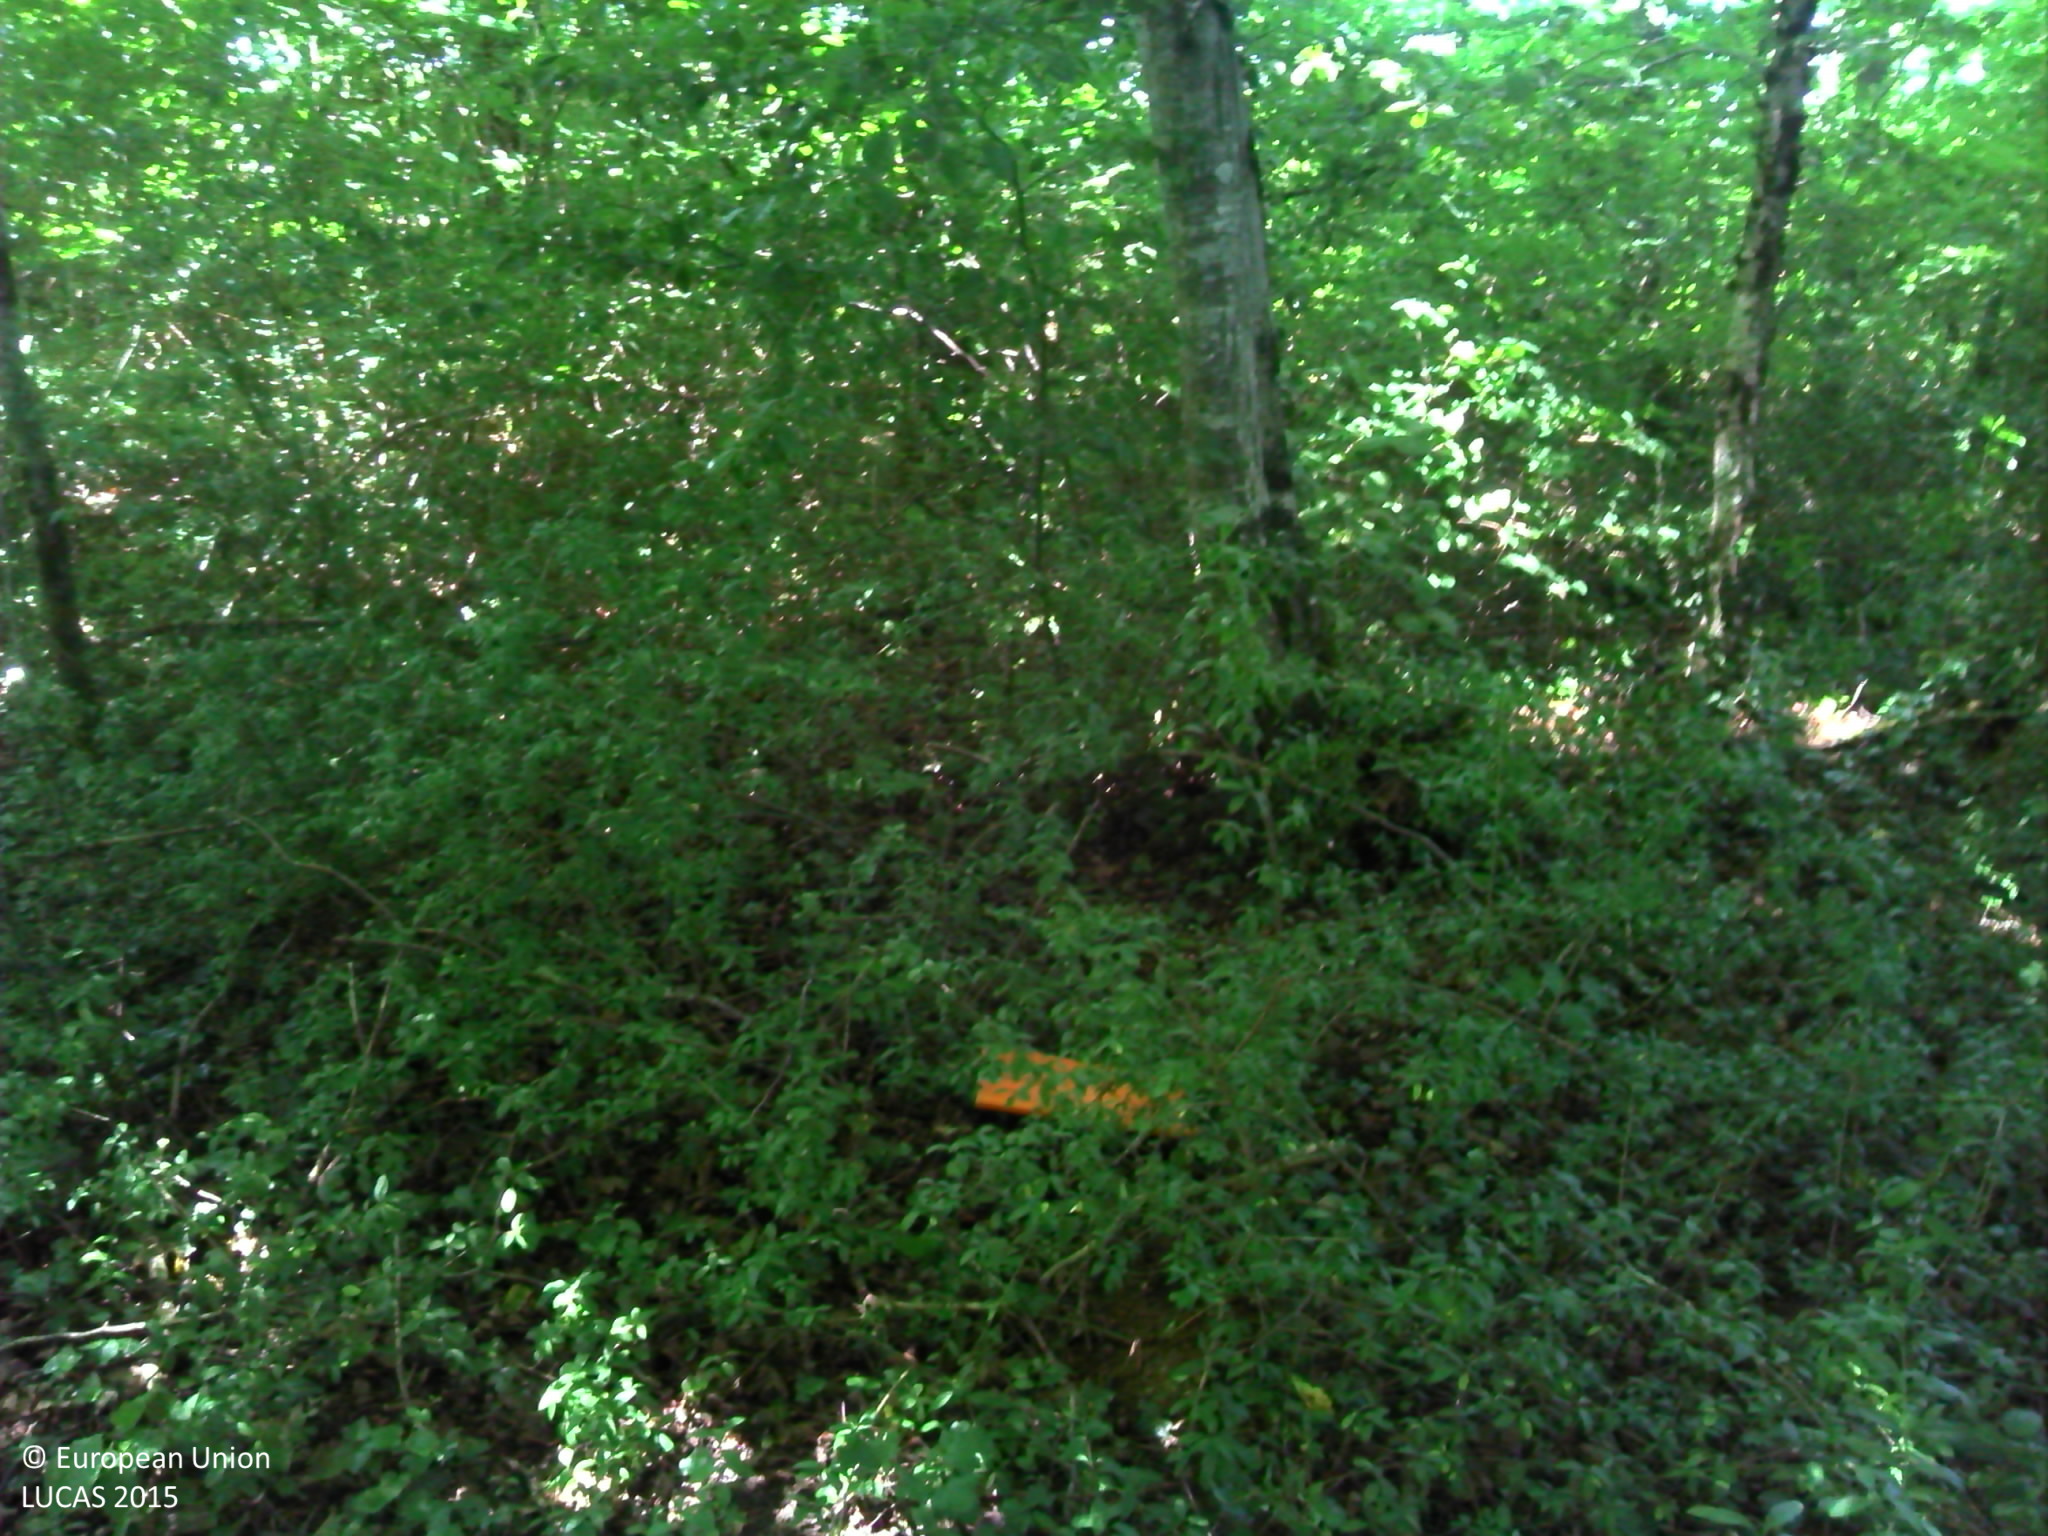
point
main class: Woodland
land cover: Broadleaved woodland
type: beech forest
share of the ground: > 75 %
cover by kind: broadleaved forest trees 90 %, herbaceous plants 10 %
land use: Forestry
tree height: > 5 m
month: June
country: FR
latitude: 47.4571
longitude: 6.2477
